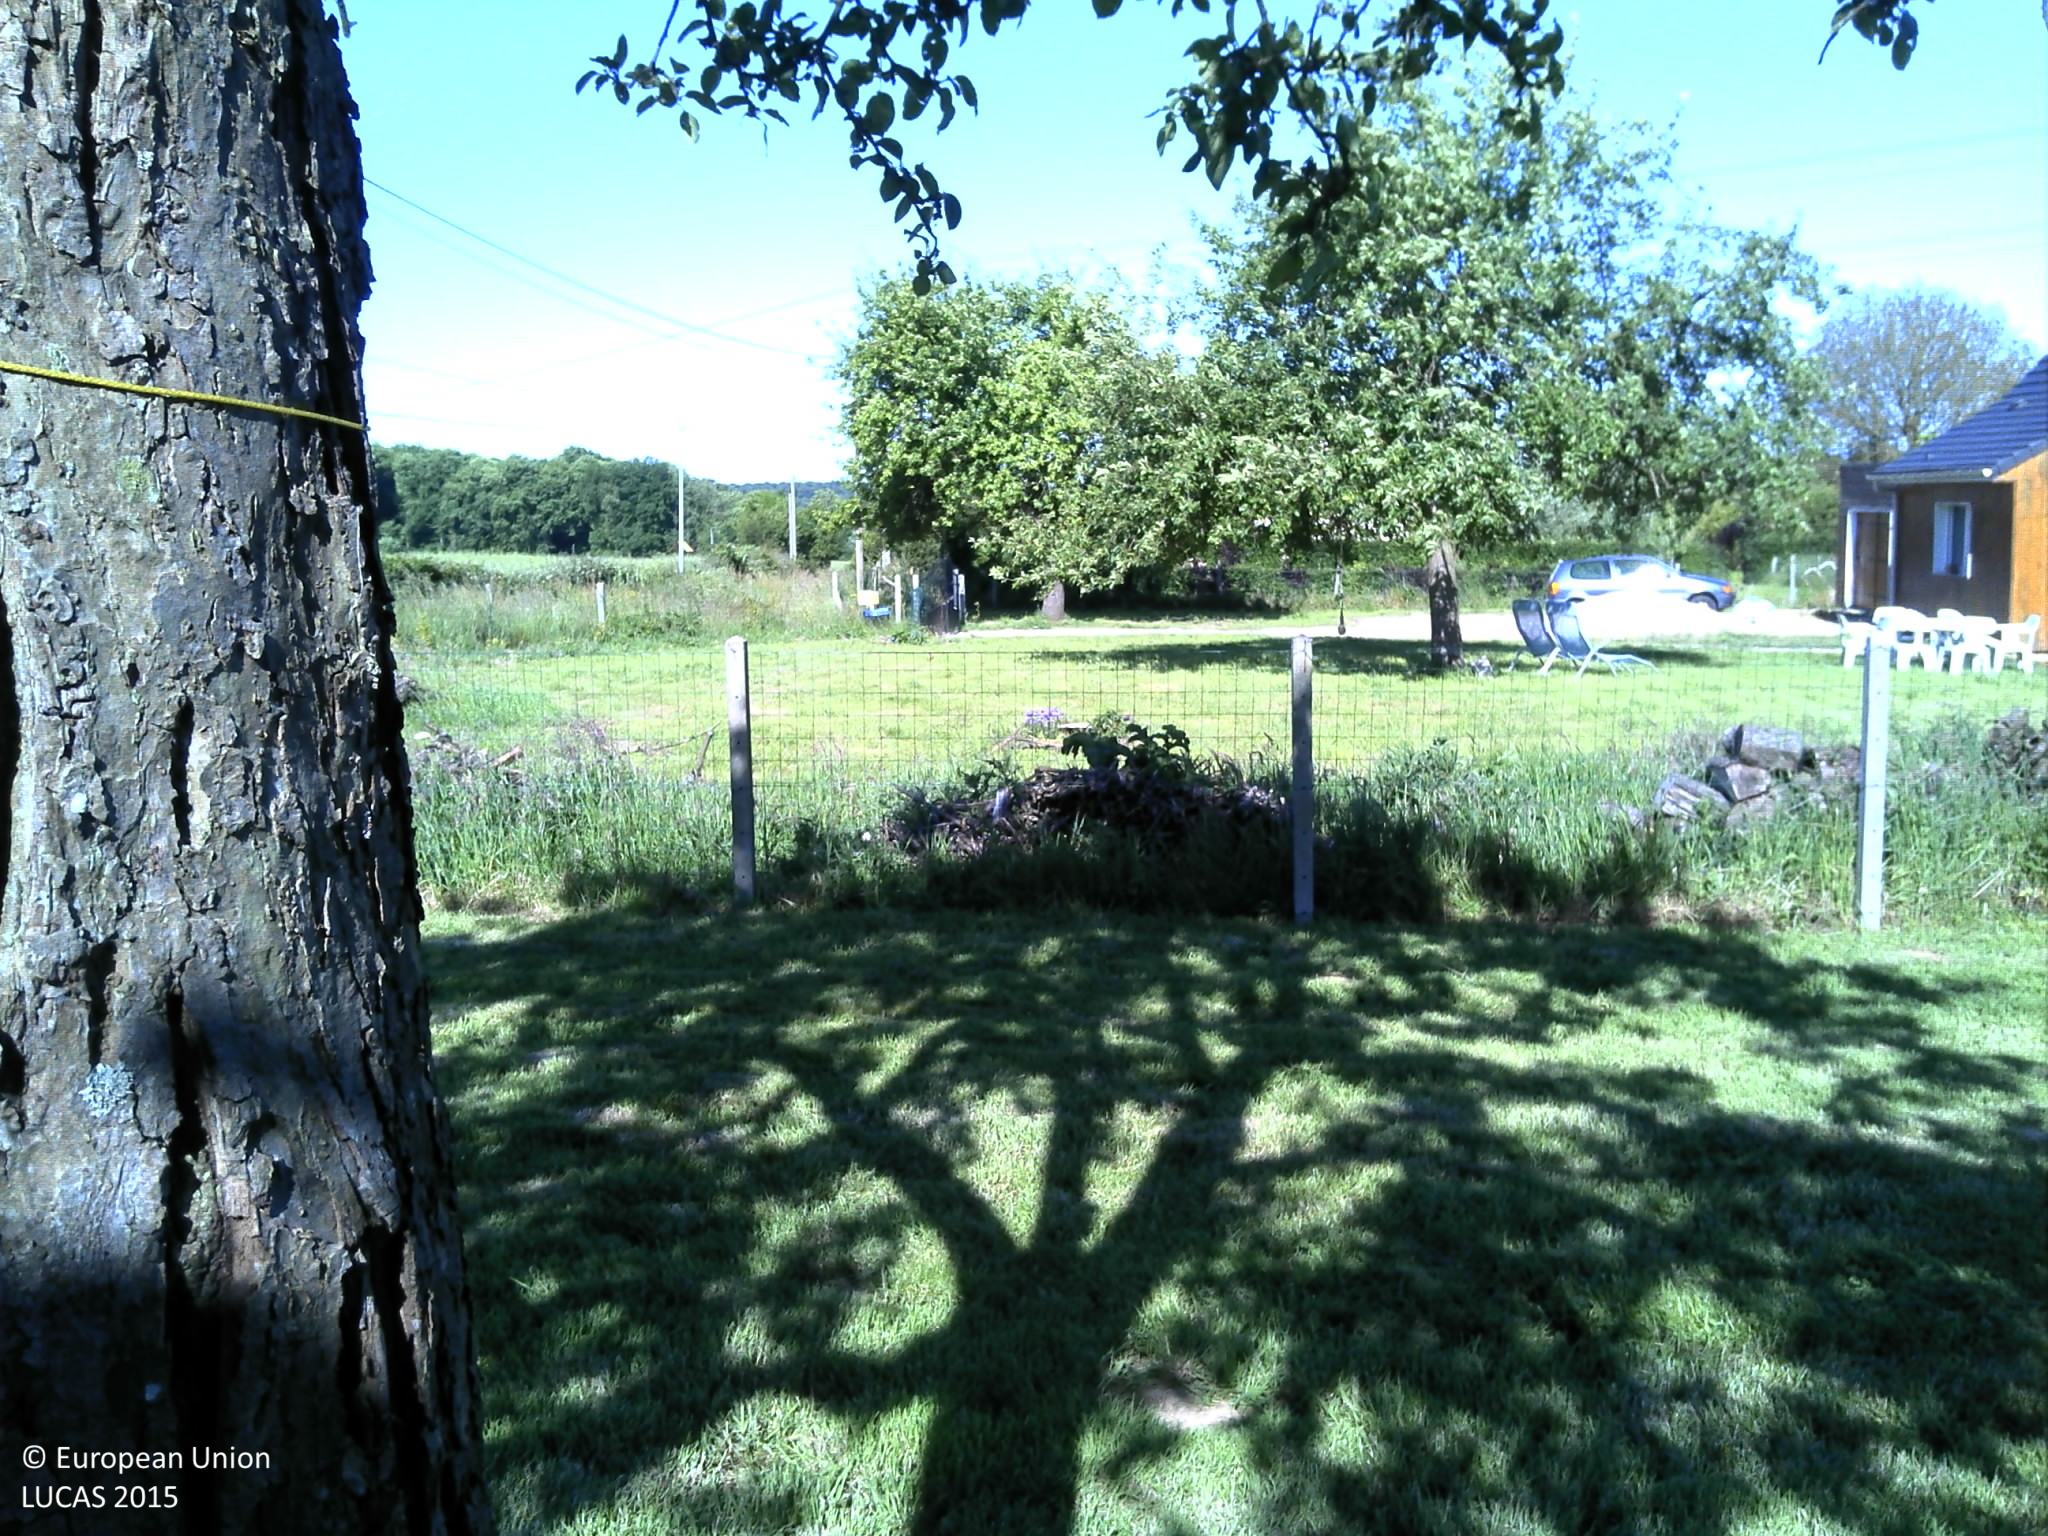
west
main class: Grassland
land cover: Grassland with sparse tree/shrub cover
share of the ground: > 75 %
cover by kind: herbaceous plants 95 %, broadleaved forest trees 5 %
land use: Residential
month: June
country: FR
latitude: 49.5833
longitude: 1.1125
